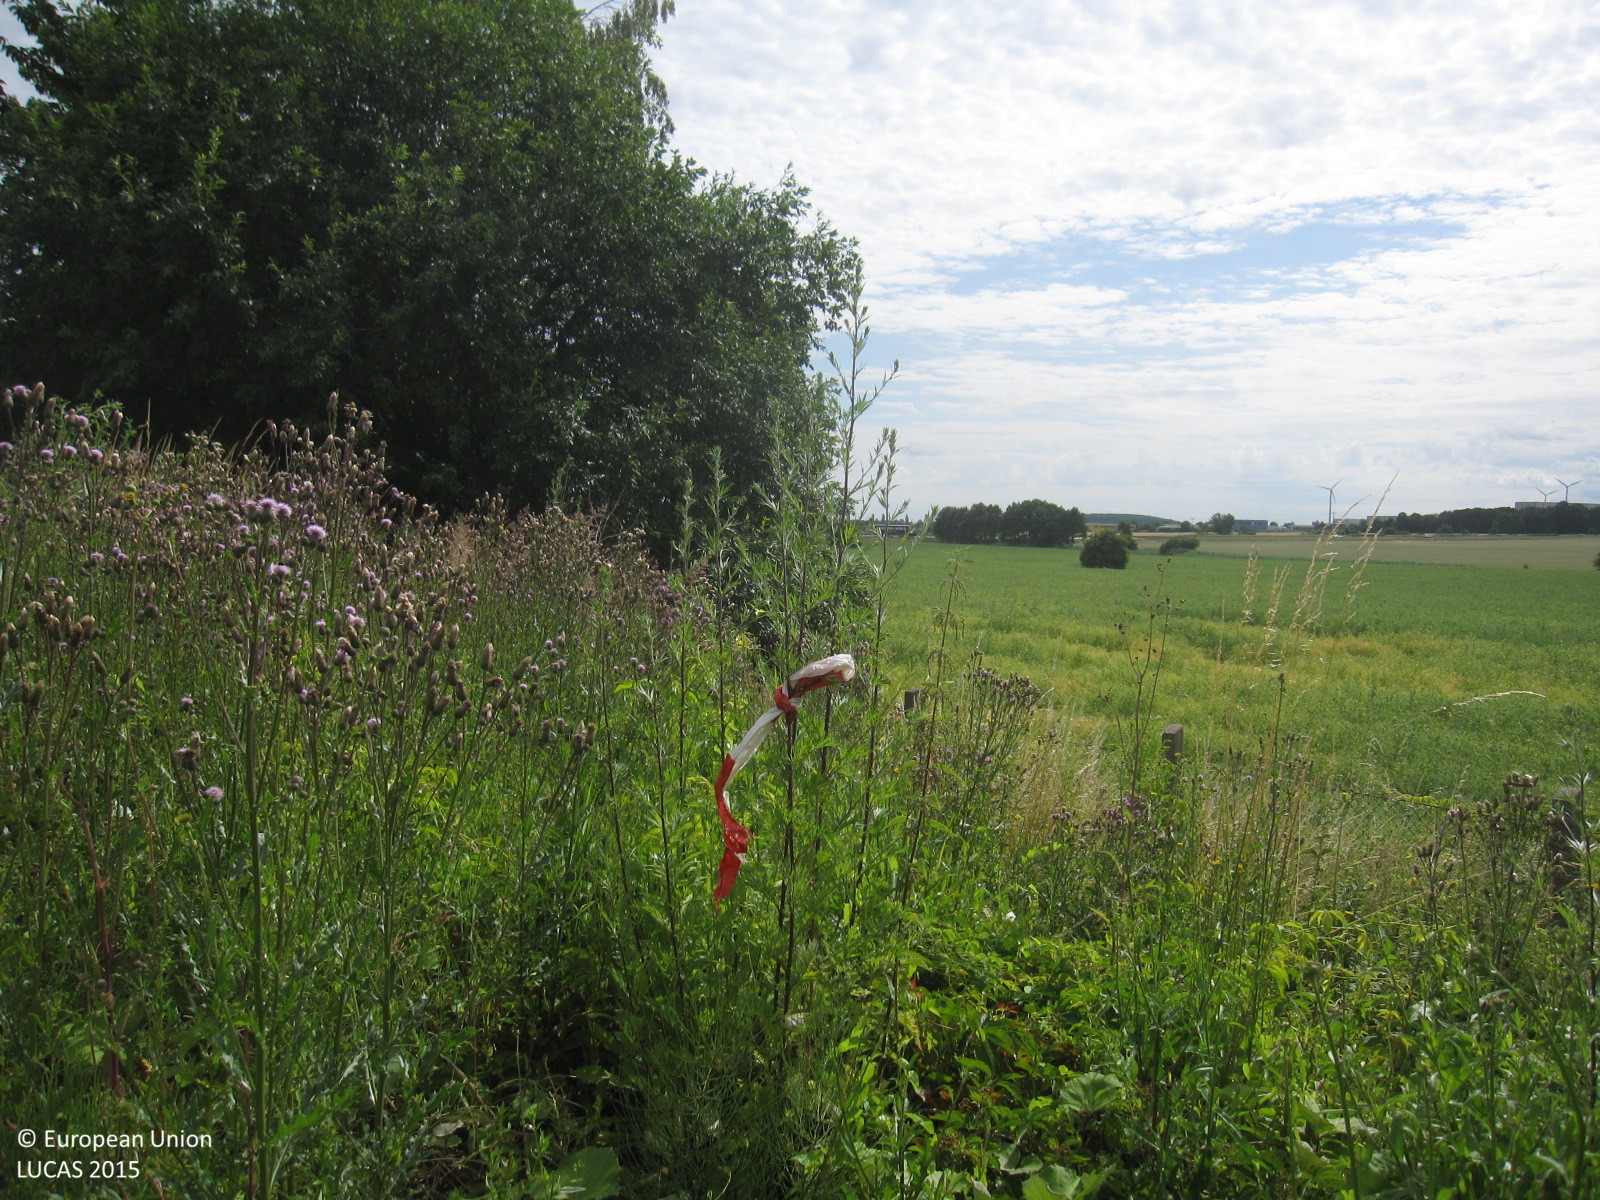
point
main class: Grassland
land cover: Spontaneously vegetated surfaces
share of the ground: > 75 %
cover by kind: herbaceous plants 90 %, consolidated bare surface 10 %
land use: Abandoned areas
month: July
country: DE
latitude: 50.8835
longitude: 12.1460
